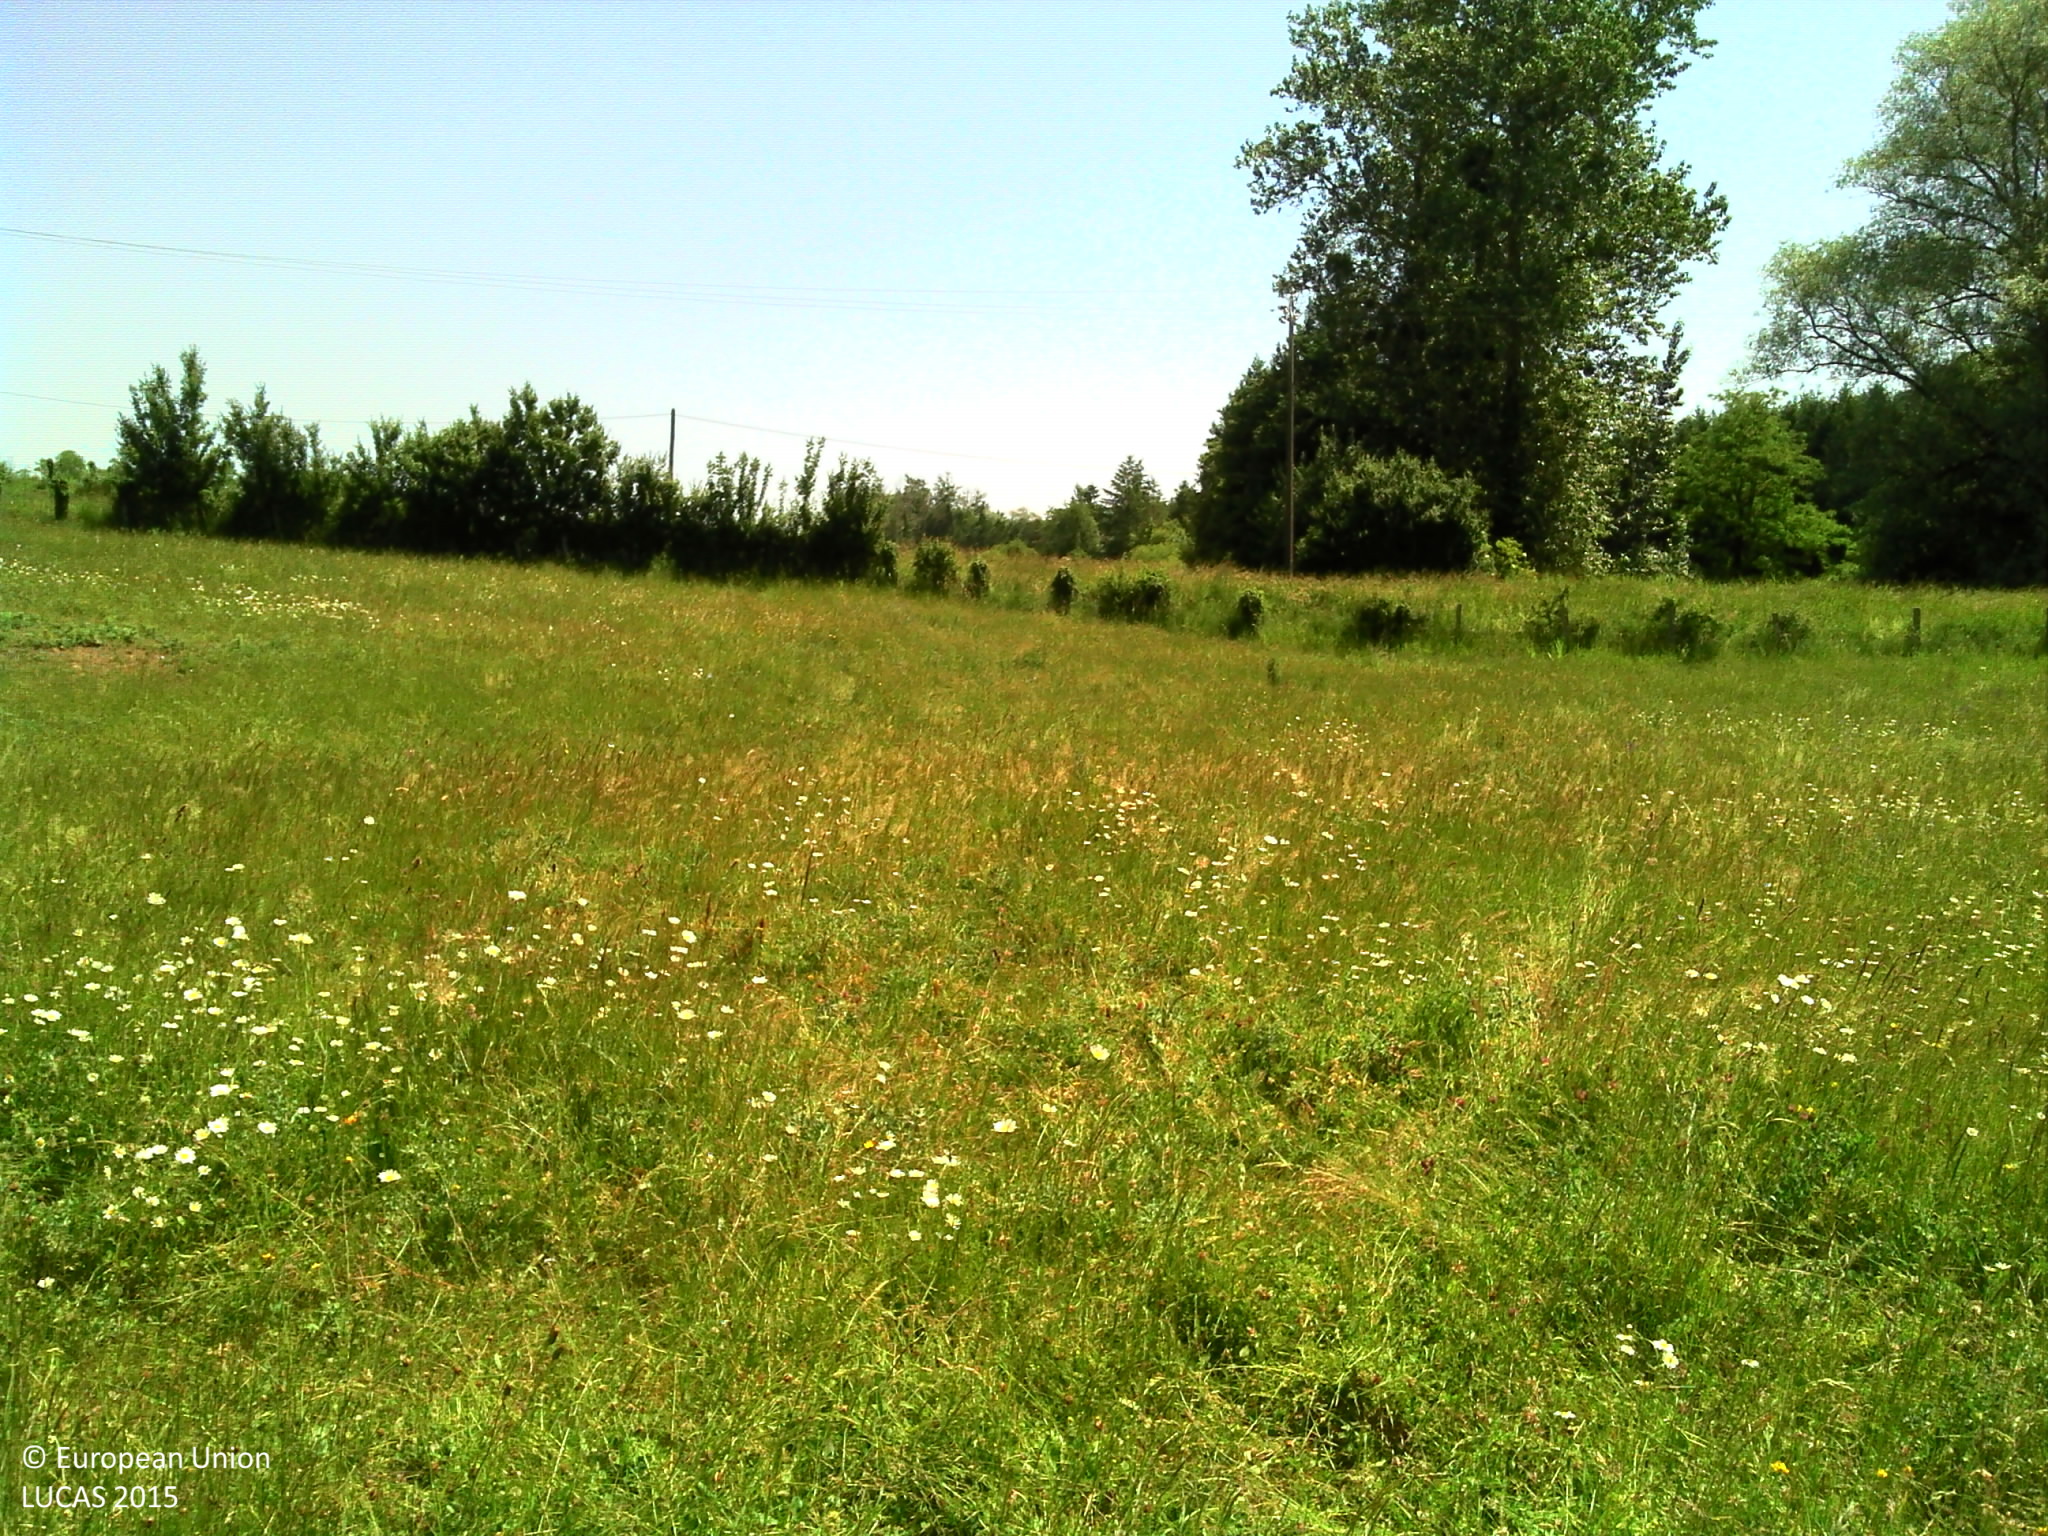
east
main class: Grassland
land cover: Grassland without tree/shrub cover
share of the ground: > 75 %
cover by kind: herbaceous plants 100 %
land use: Agriculture (excluding fallow land and kitchen gardens)
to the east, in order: Grassland without tree/shrub cover; Fences; Grass margins; Paved roads, cycling and walking lanes; Grass margins; Ditches and canals; Electric lines; Fences; Grassland without tree/shrub cover
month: June
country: FR
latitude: 46.9689
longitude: 2.9638
